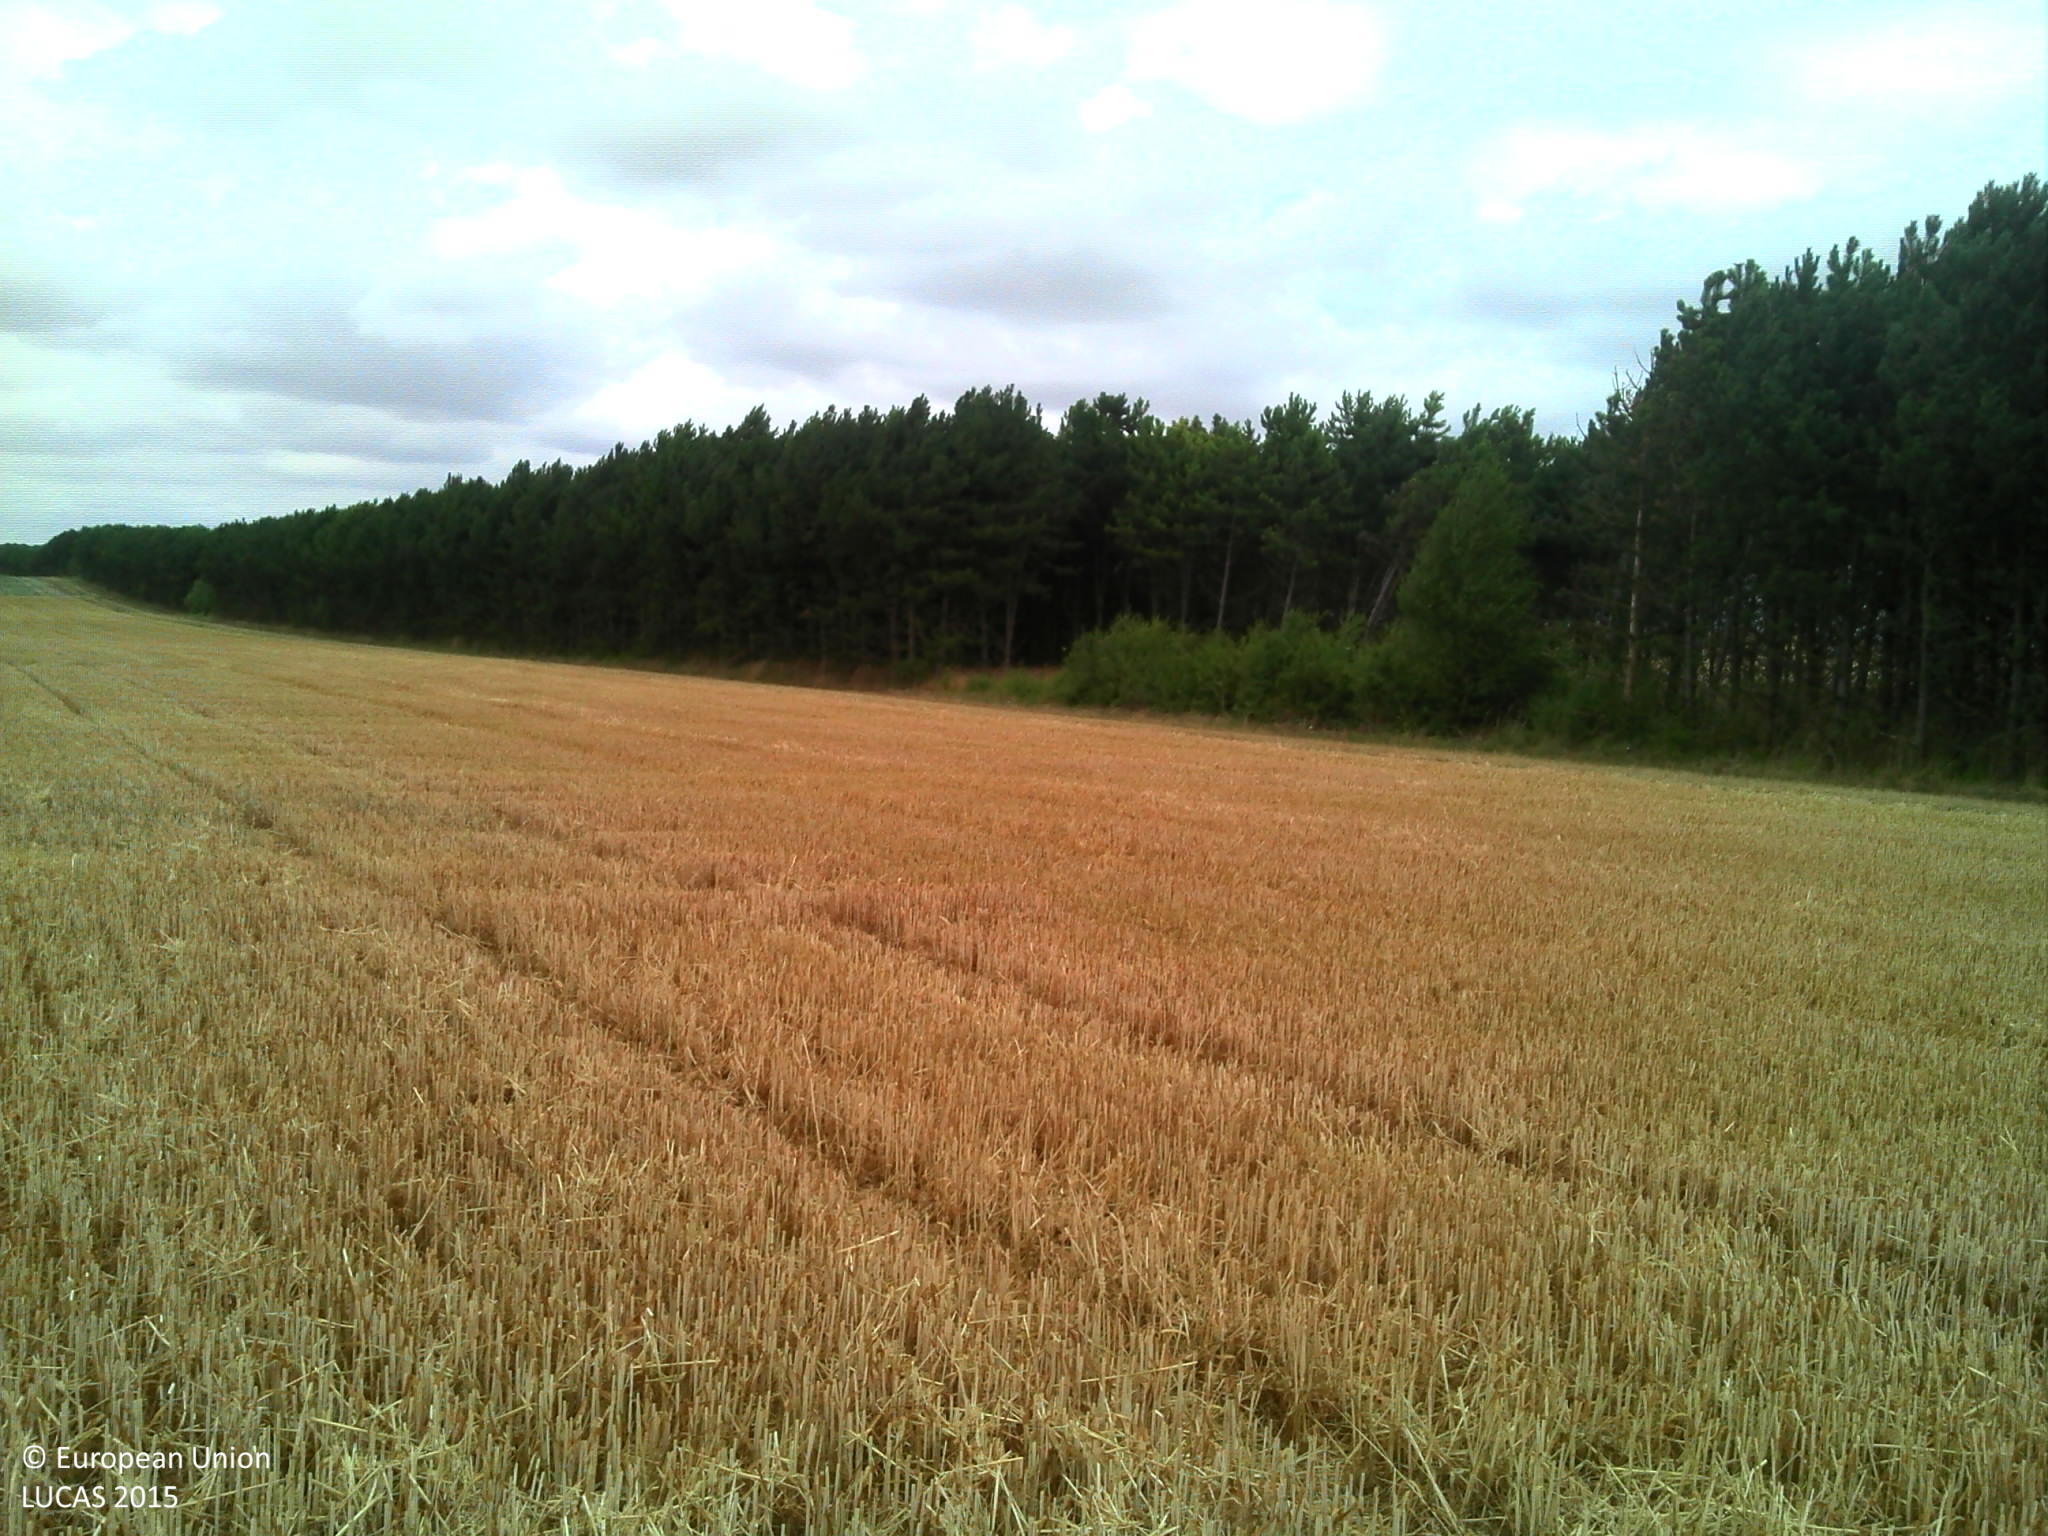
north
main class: Cropland
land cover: Common wheat
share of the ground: > 75 %
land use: Agriculture (excluding fallow land and kitchen gardens)
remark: Harvested field
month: July
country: FR
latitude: 48.7915
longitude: 4.1836
